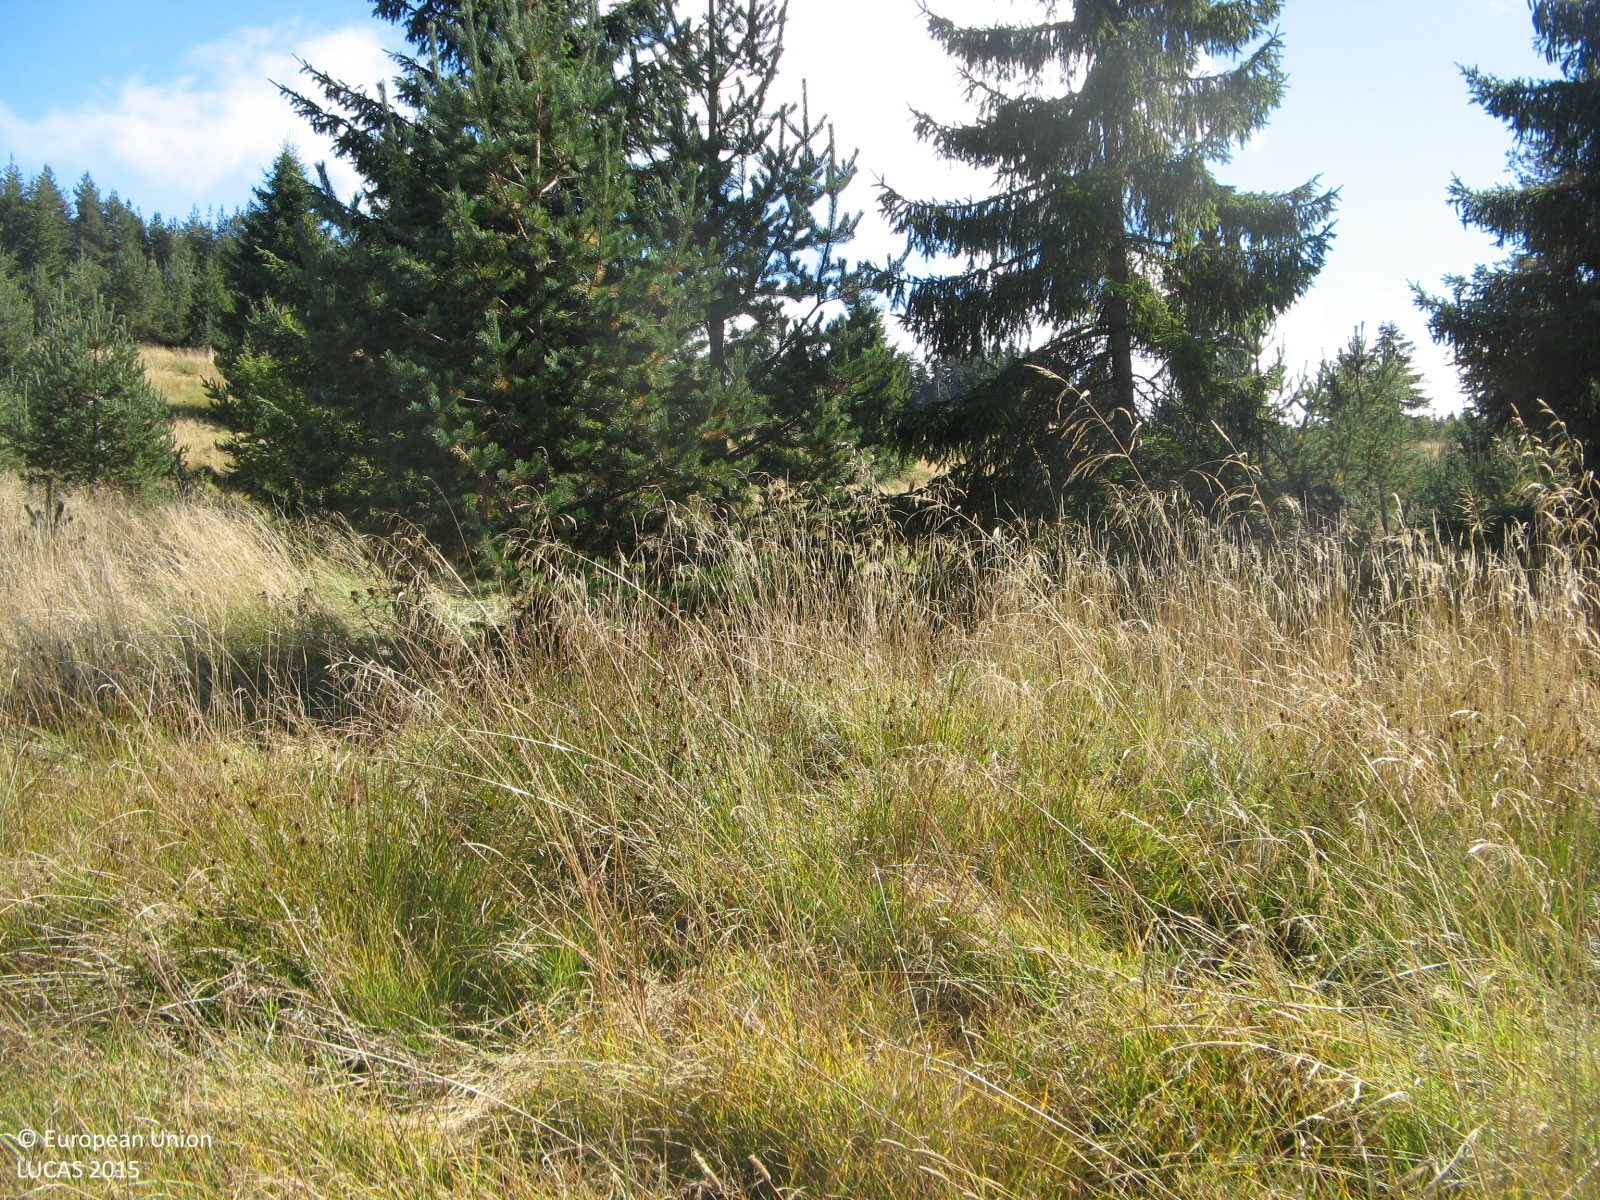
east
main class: Grassland
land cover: Grassland with sparse tree/shrub cover
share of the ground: > 75 %
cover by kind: herbaceous plants 90 %, coniferous forest trees 5 %, shrubs 5 %
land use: Fallow land
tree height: < 5 m
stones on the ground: < 10 %
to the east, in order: Grassland with sparse tree/shrub cover; Dry stone walls; Grassland without tree/shrub cover; Grassland with sparse tree/shrub cover; Pine dominated coniferous woodland; Grassland with sparse tree/shrub cover; Pine dominated coniferous woodland; Grassland with sparse tree/shrub cover
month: September
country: BG
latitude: 41.5971
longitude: 24.4242
